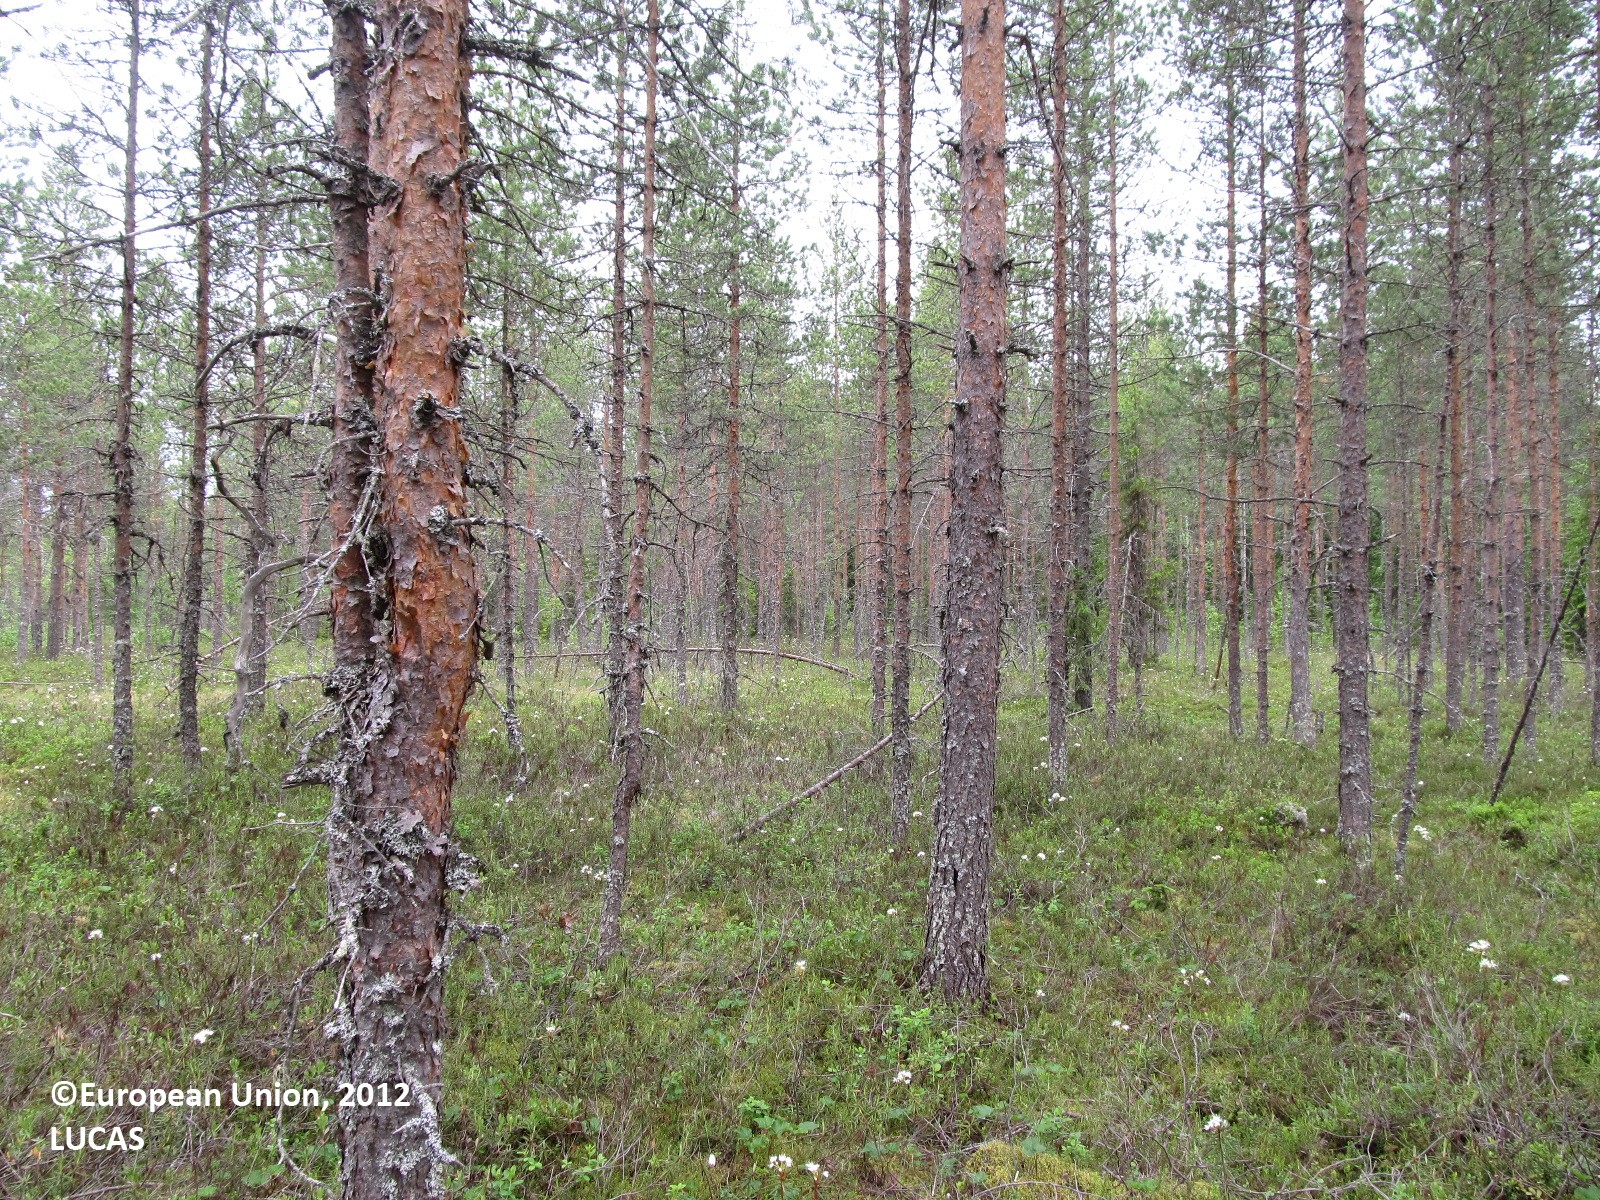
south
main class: Woodland
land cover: Pine dominated coniferous woodland
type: boreal forest
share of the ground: 25 - 50 %
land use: Forestry
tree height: > 5 m
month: June
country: FI
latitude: 63.3010
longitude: 27.8237
